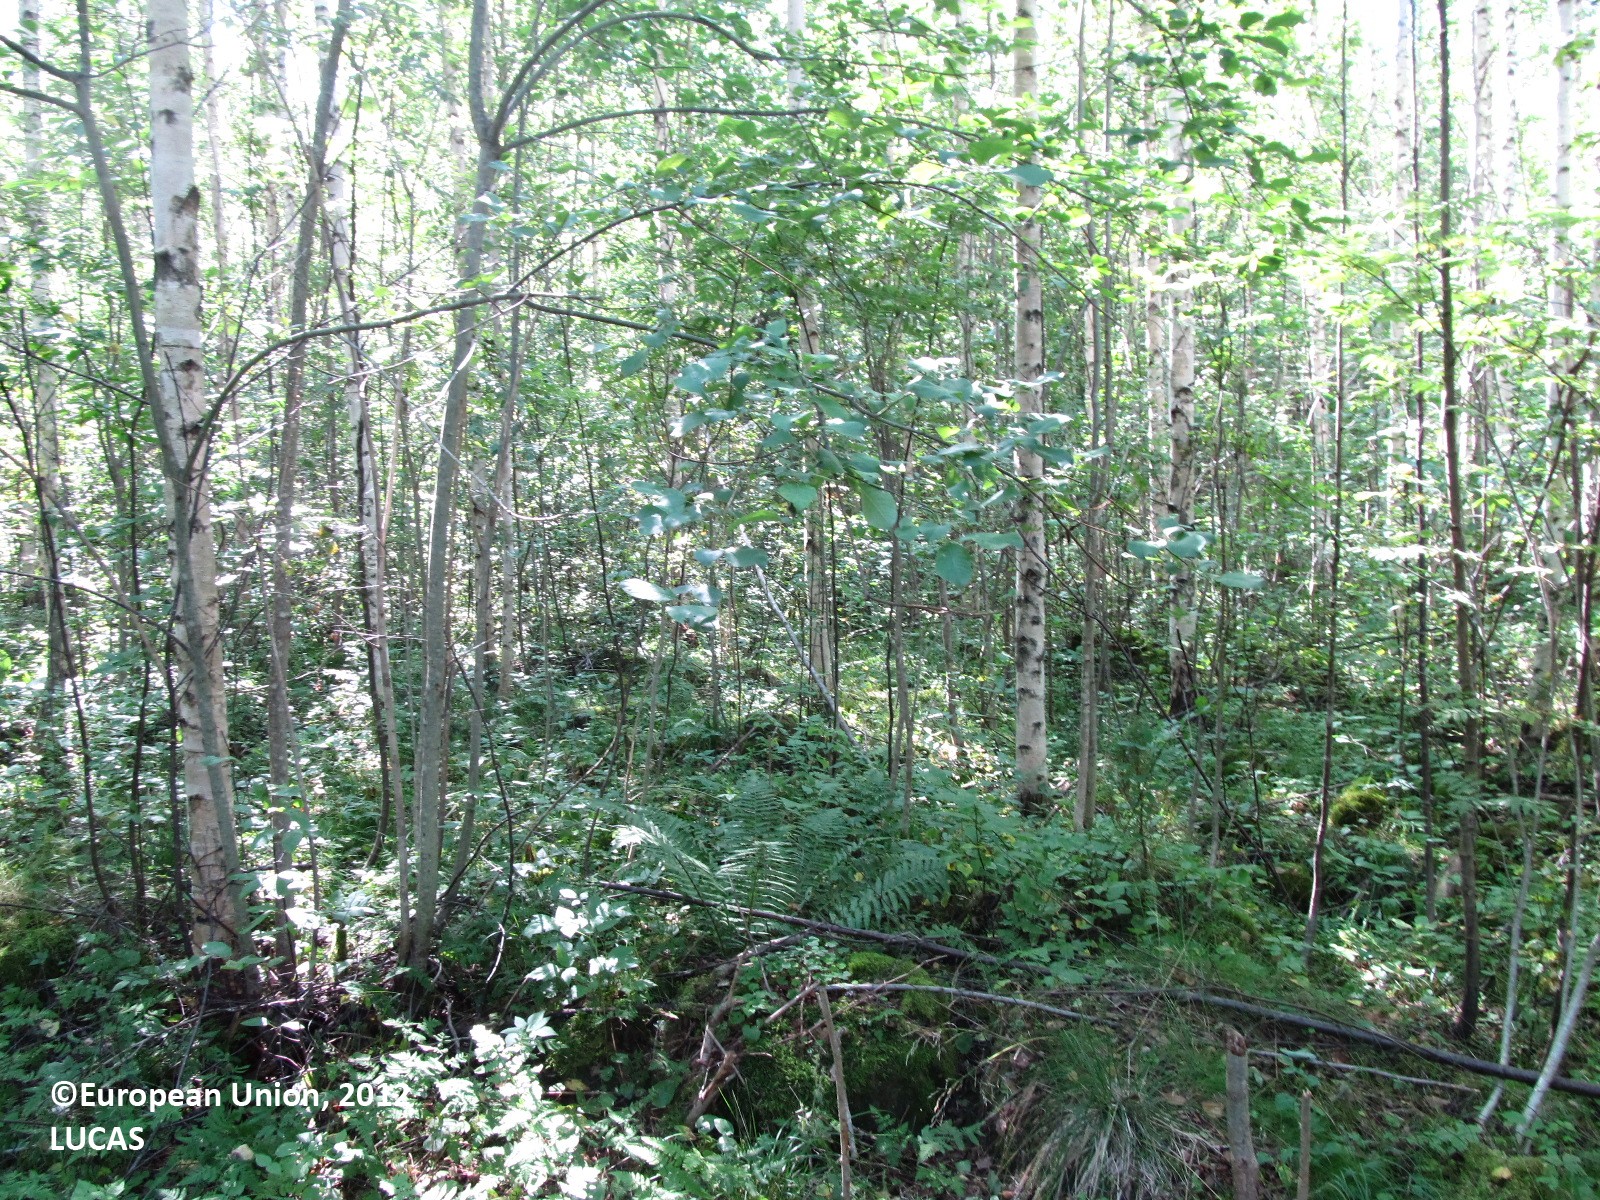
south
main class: Woodland
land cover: Broadleaved woodland
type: boreal forest
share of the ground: 50 - 75 %
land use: Forestry
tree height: > 5 m
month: August
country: FI
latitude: 62.1791
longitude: 28.4691
